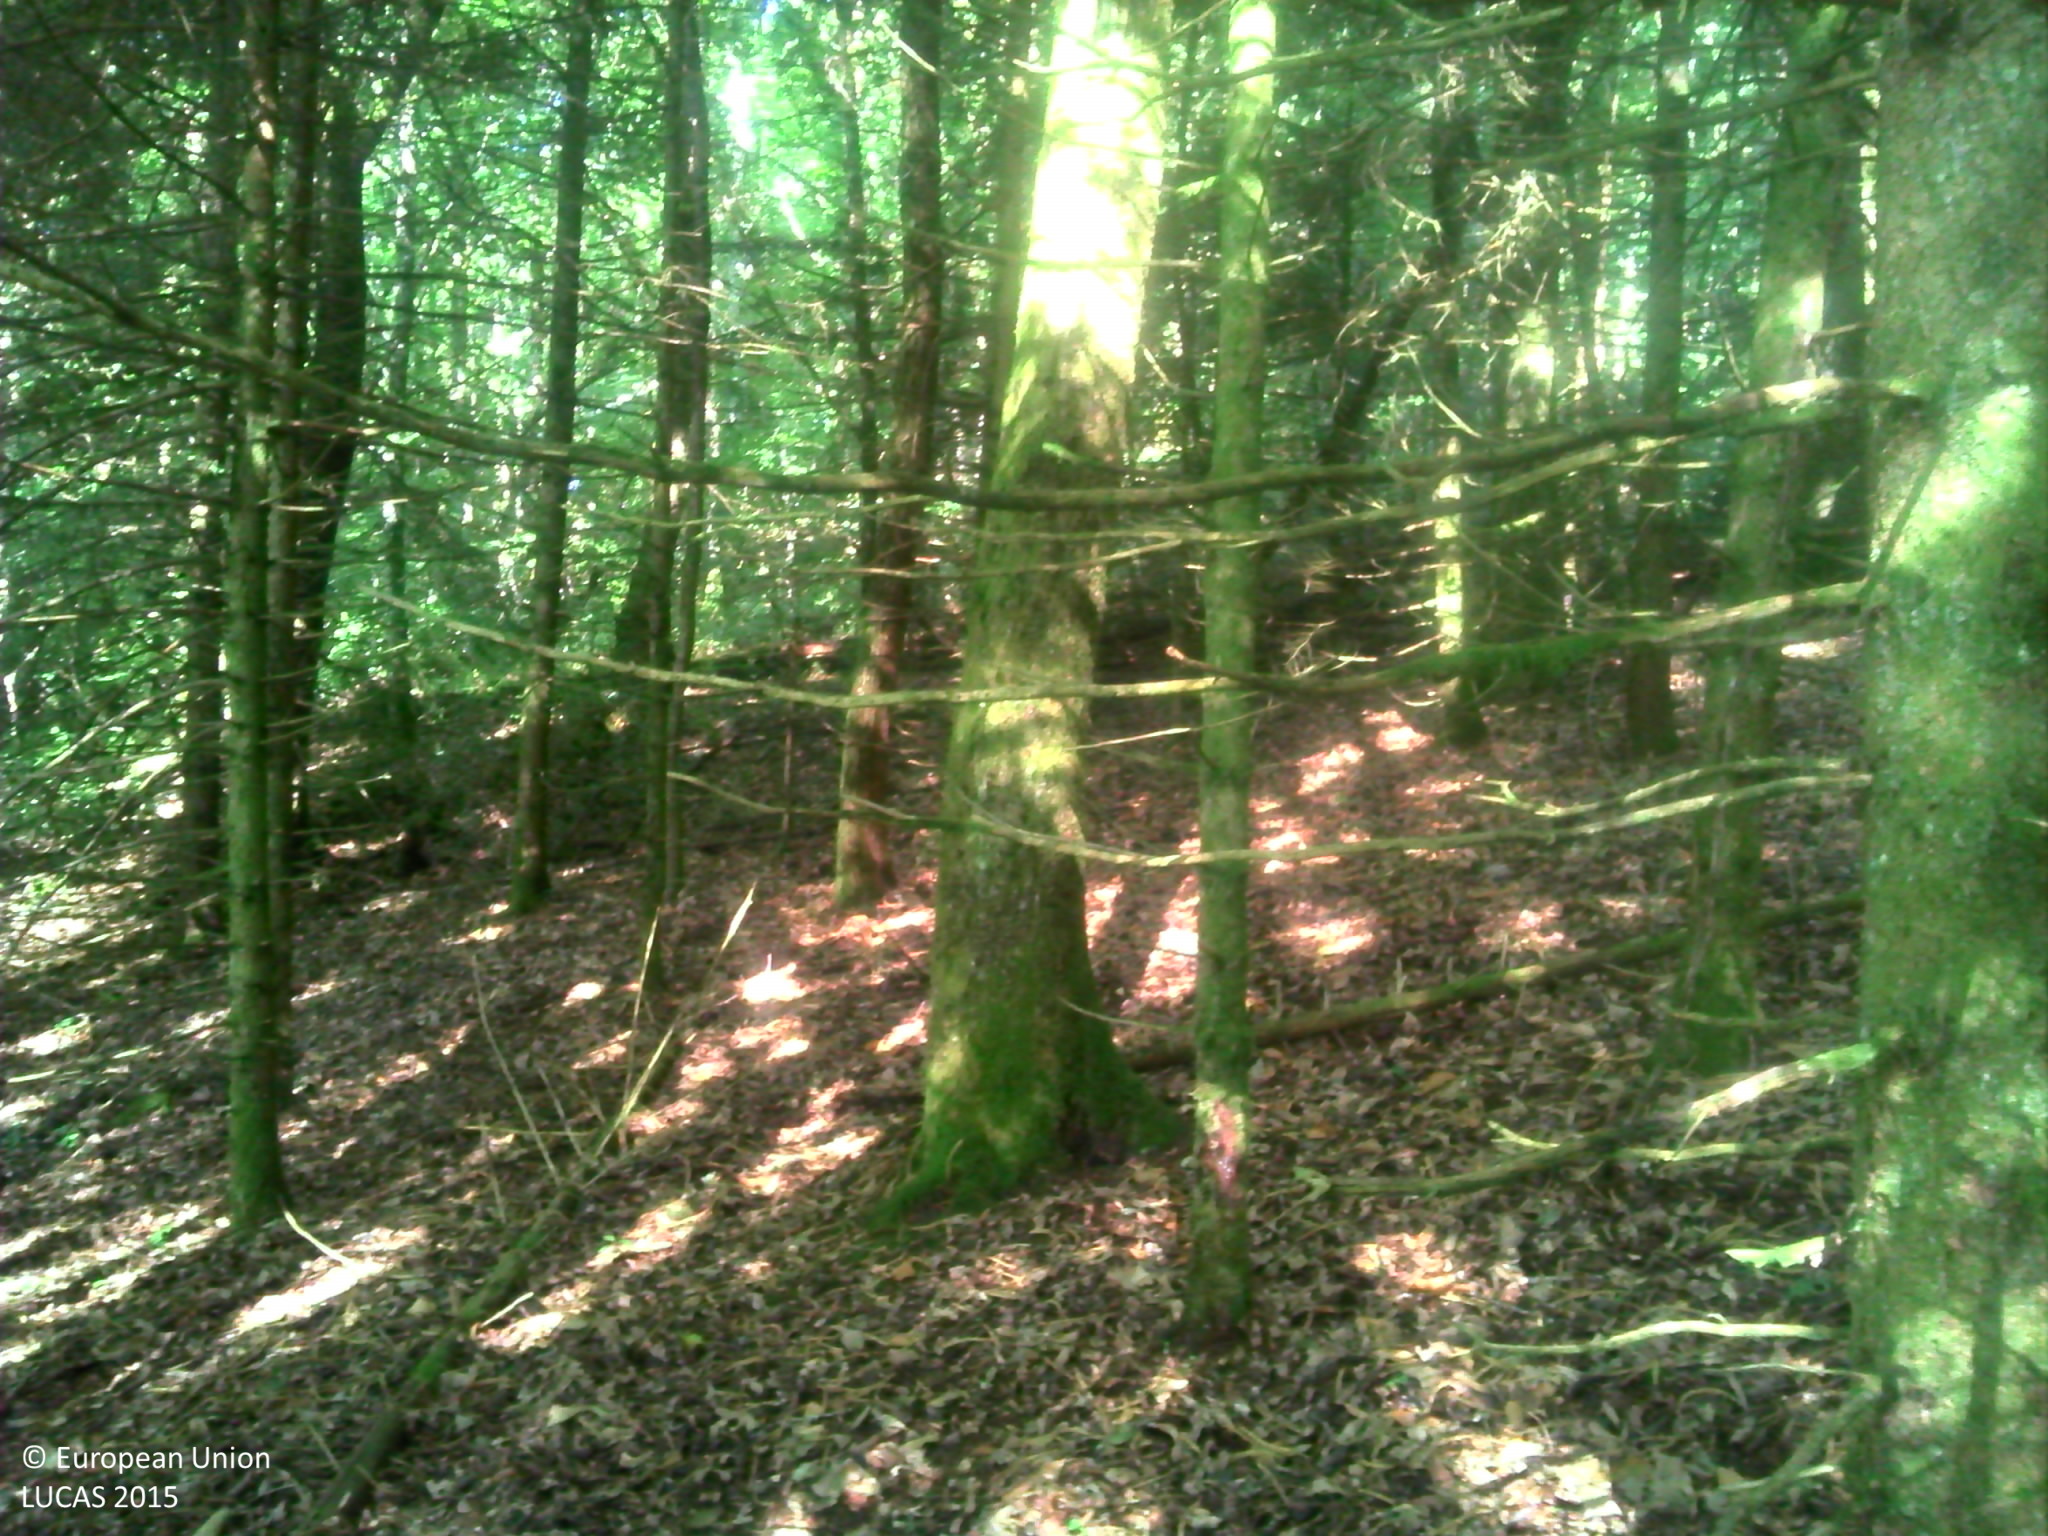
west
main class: Woodland
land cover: Spruce dominated mixed woodland
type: thermophilous deciduous forest
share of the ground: 50 - 75 %
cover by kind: coniferous forest trees 65 %, broadleaved forest trees 25 %, herbaceous plants 5 %, lichens and mosses 5 %
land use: Forestry
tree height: > 5 m
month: July
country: FR
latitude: 45.6156
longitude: 1.7487
